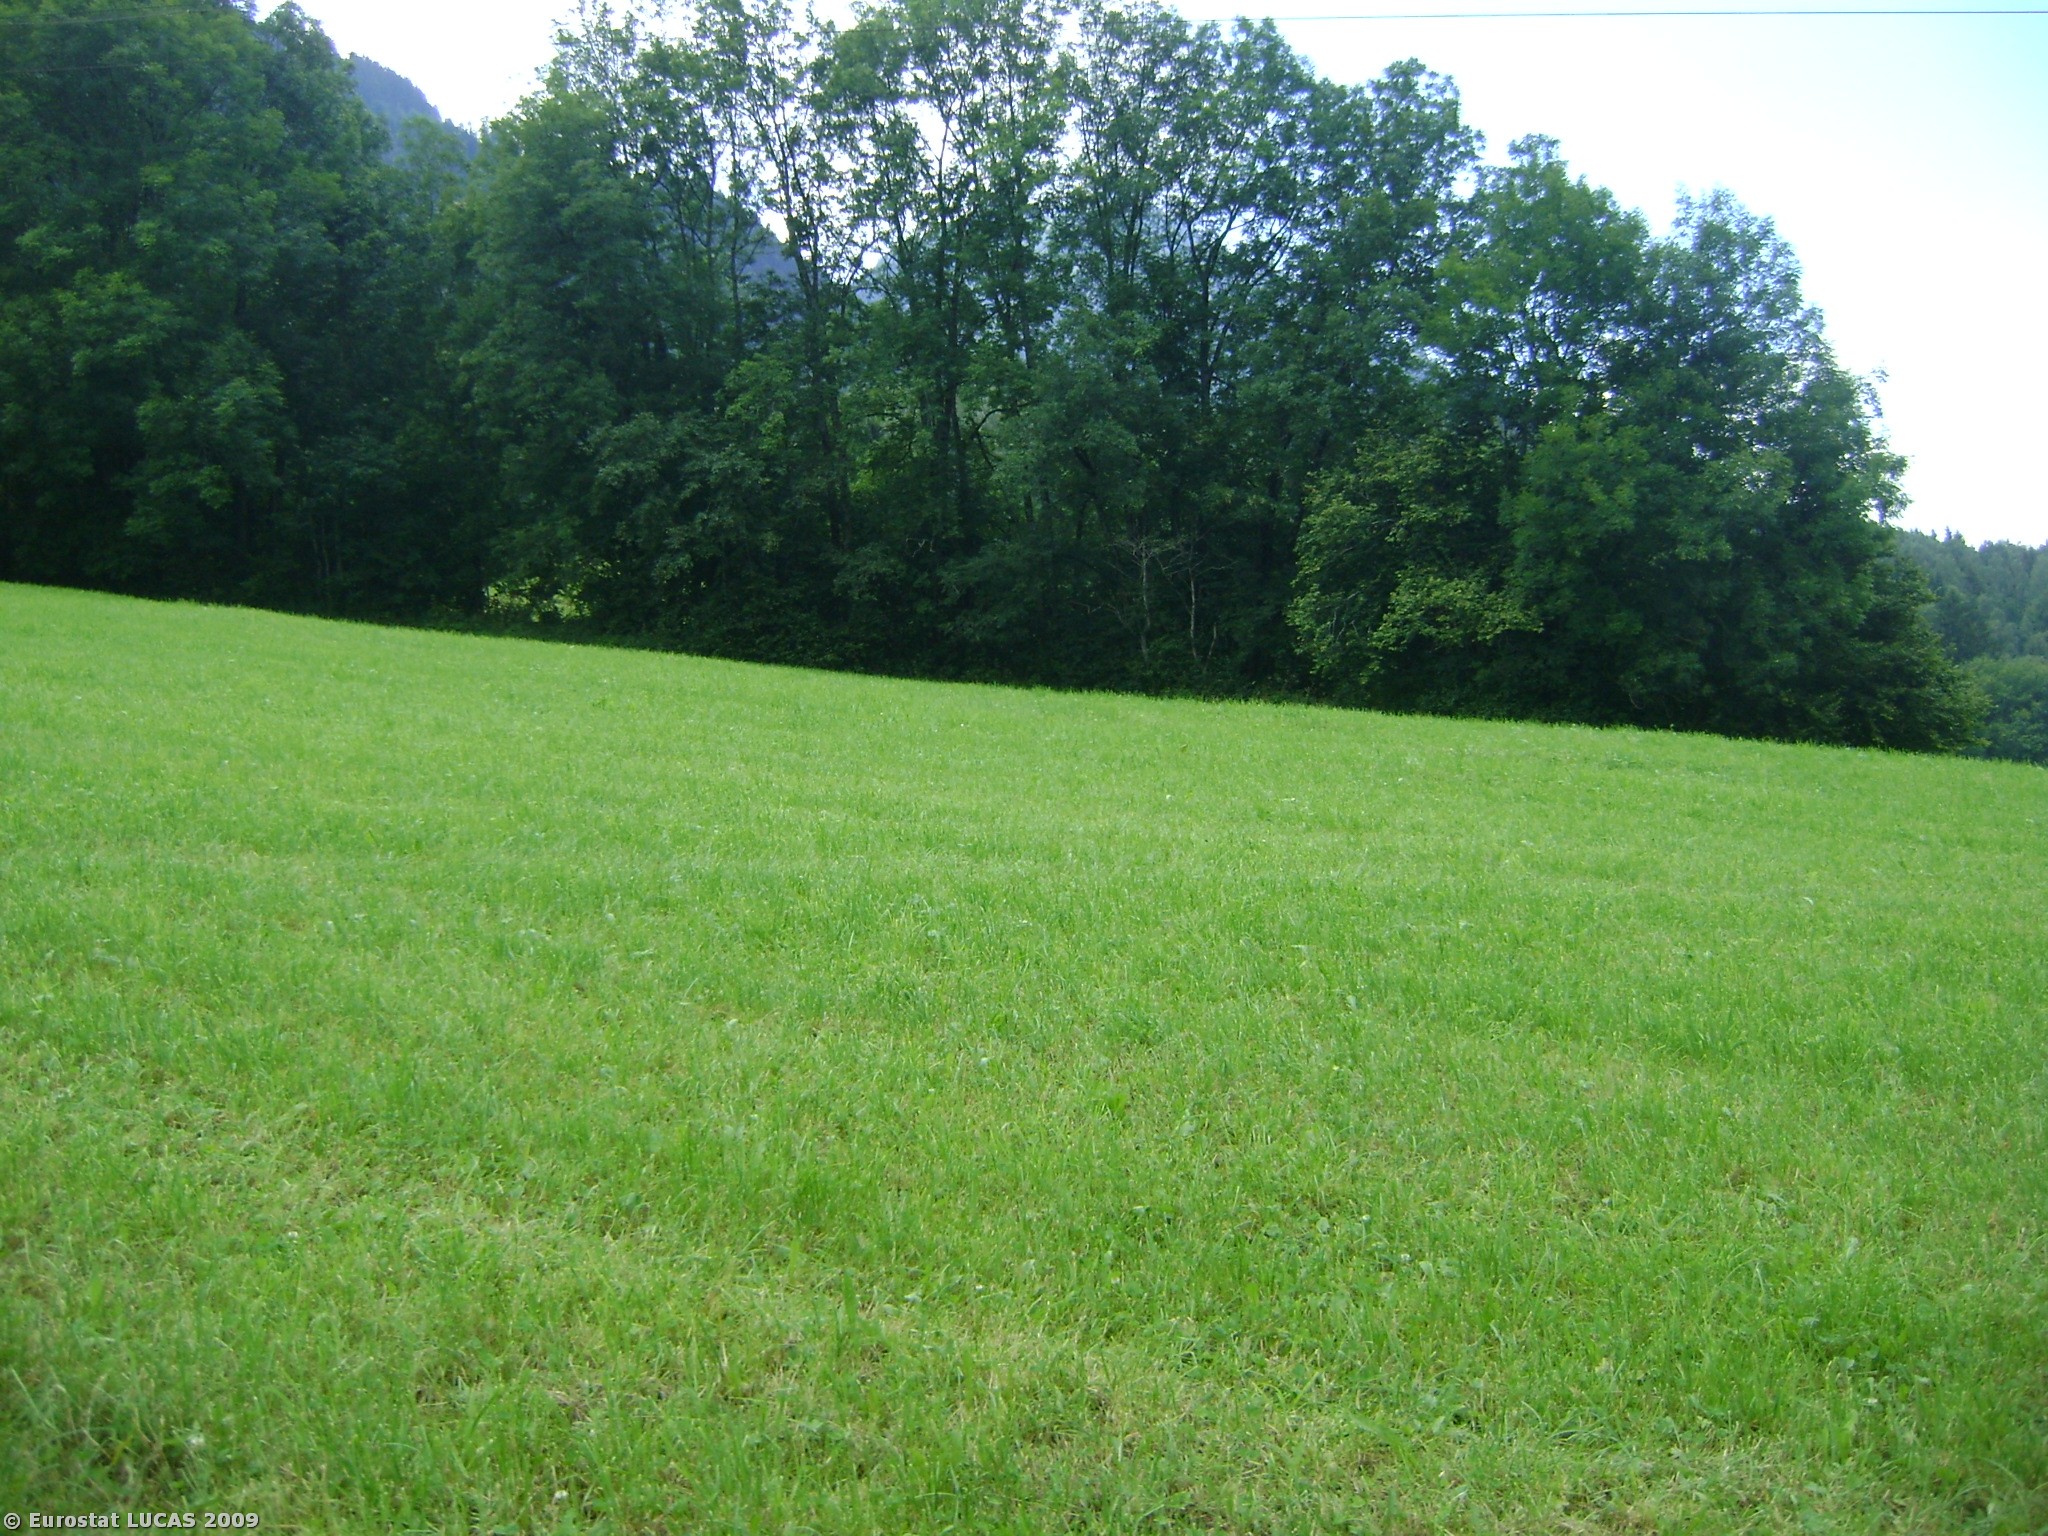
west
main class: Grassland
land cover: Grassland without tree/shrub cover
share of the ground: > 75 %
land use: Agriculture (excluding fallow land and kitchen gardens)
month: August
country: AT
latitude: 47.1791
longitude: 9.6705
